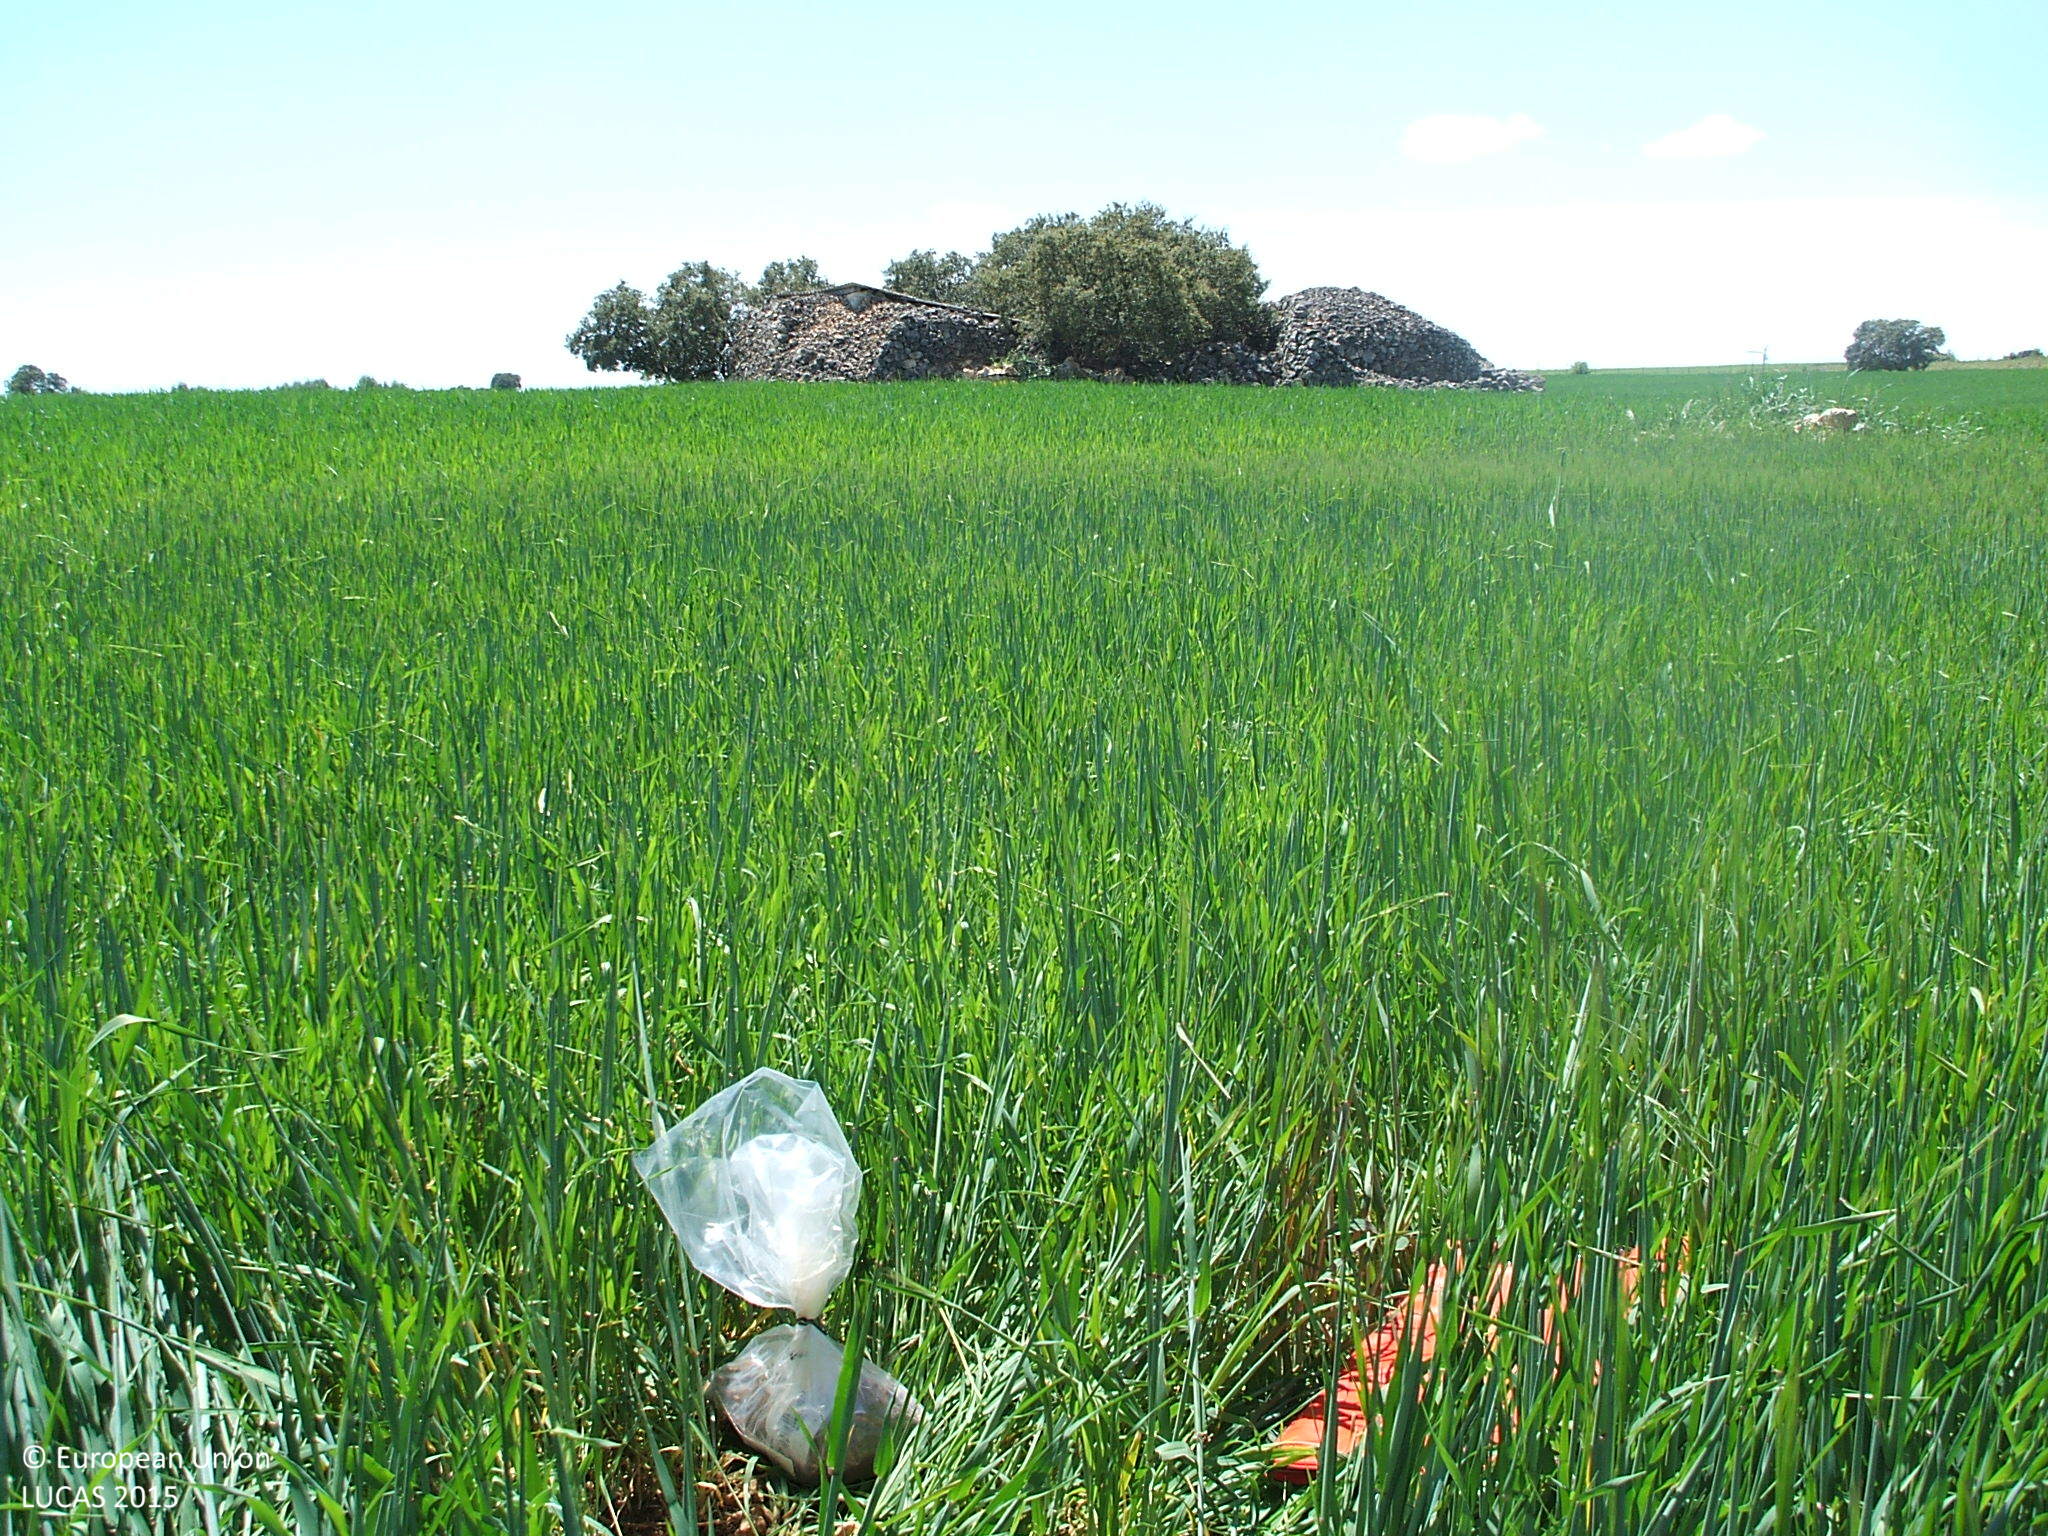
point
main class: Cropland
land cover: Barley
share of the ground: > 75 %
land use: Agriculture (excluding fallow land and kitchen gardens)
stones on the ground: 25 - 50 %
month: May
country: ES
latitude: 40.6838
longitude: -2.9641
